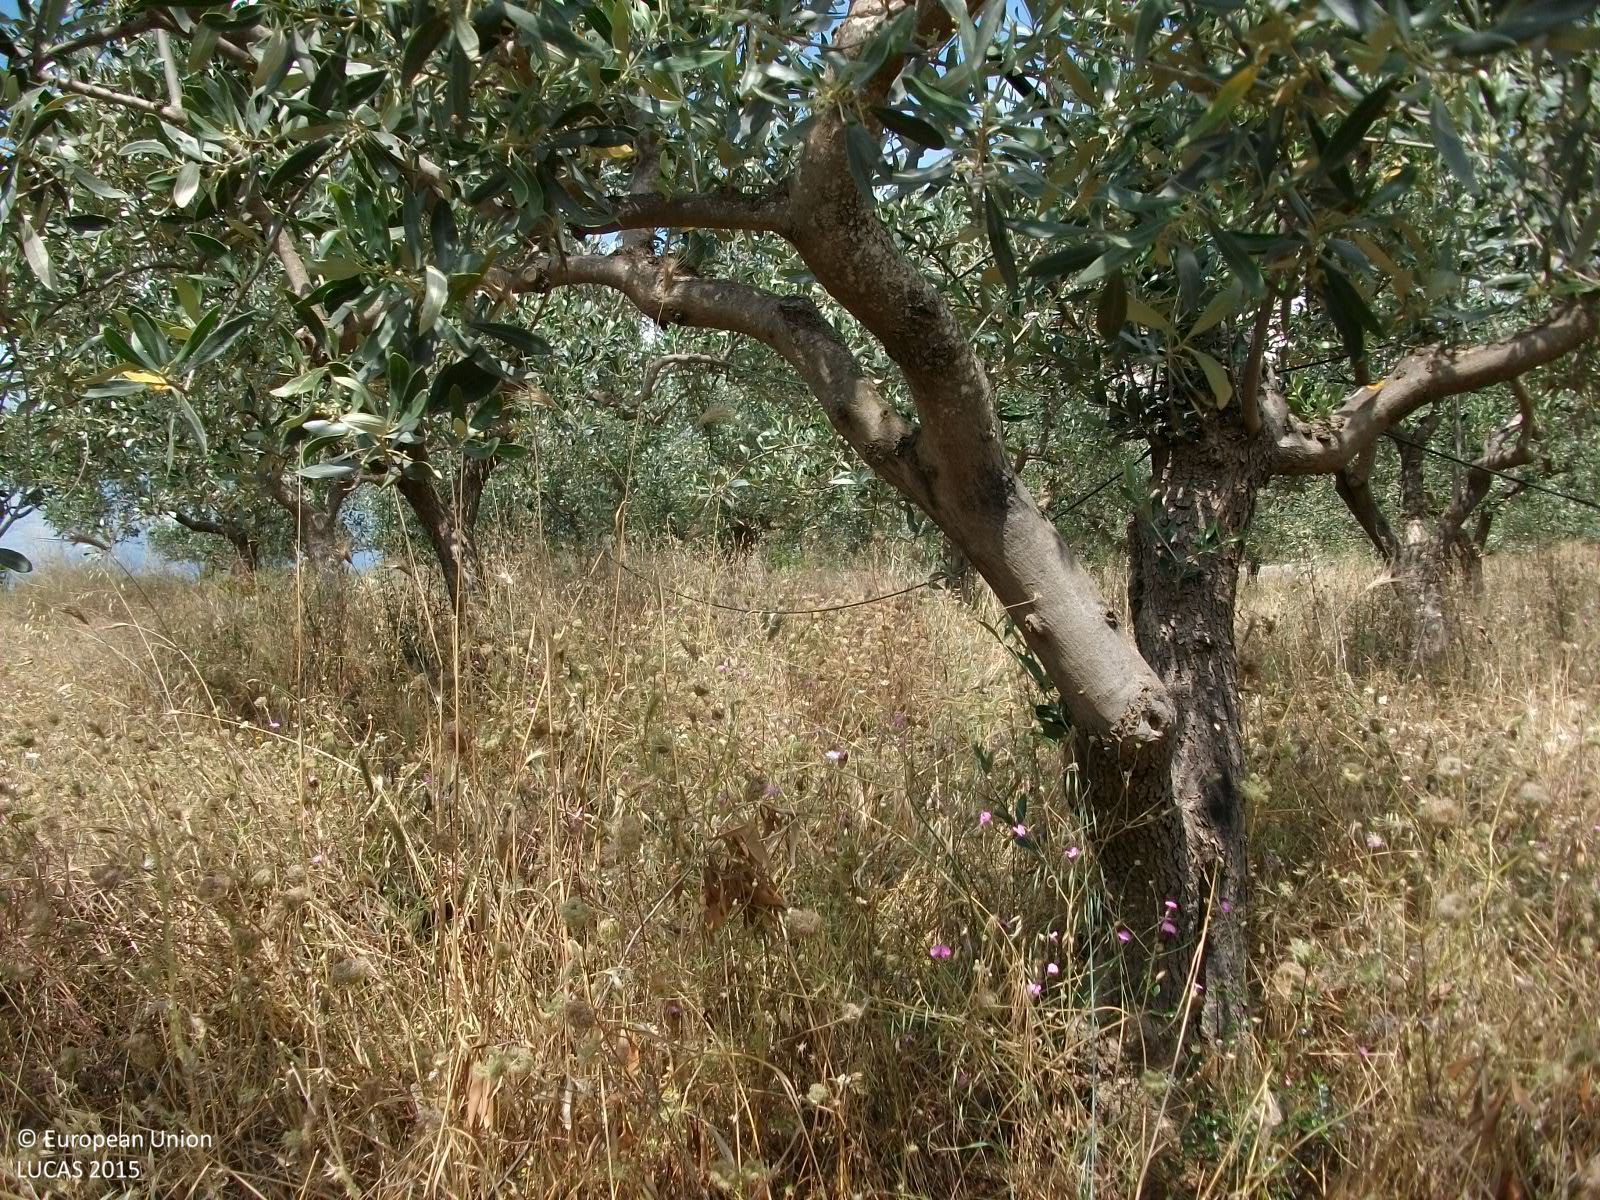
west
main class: Cropland
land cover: Olive groves
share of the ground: 50 - 75 %
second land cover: Spontaneously vegetated surfaces
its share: > 75 %
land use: Agriculture (excluding fallow land and kitchen gardens)
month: June
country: GR
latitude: 37.1647
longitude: 22.4462
